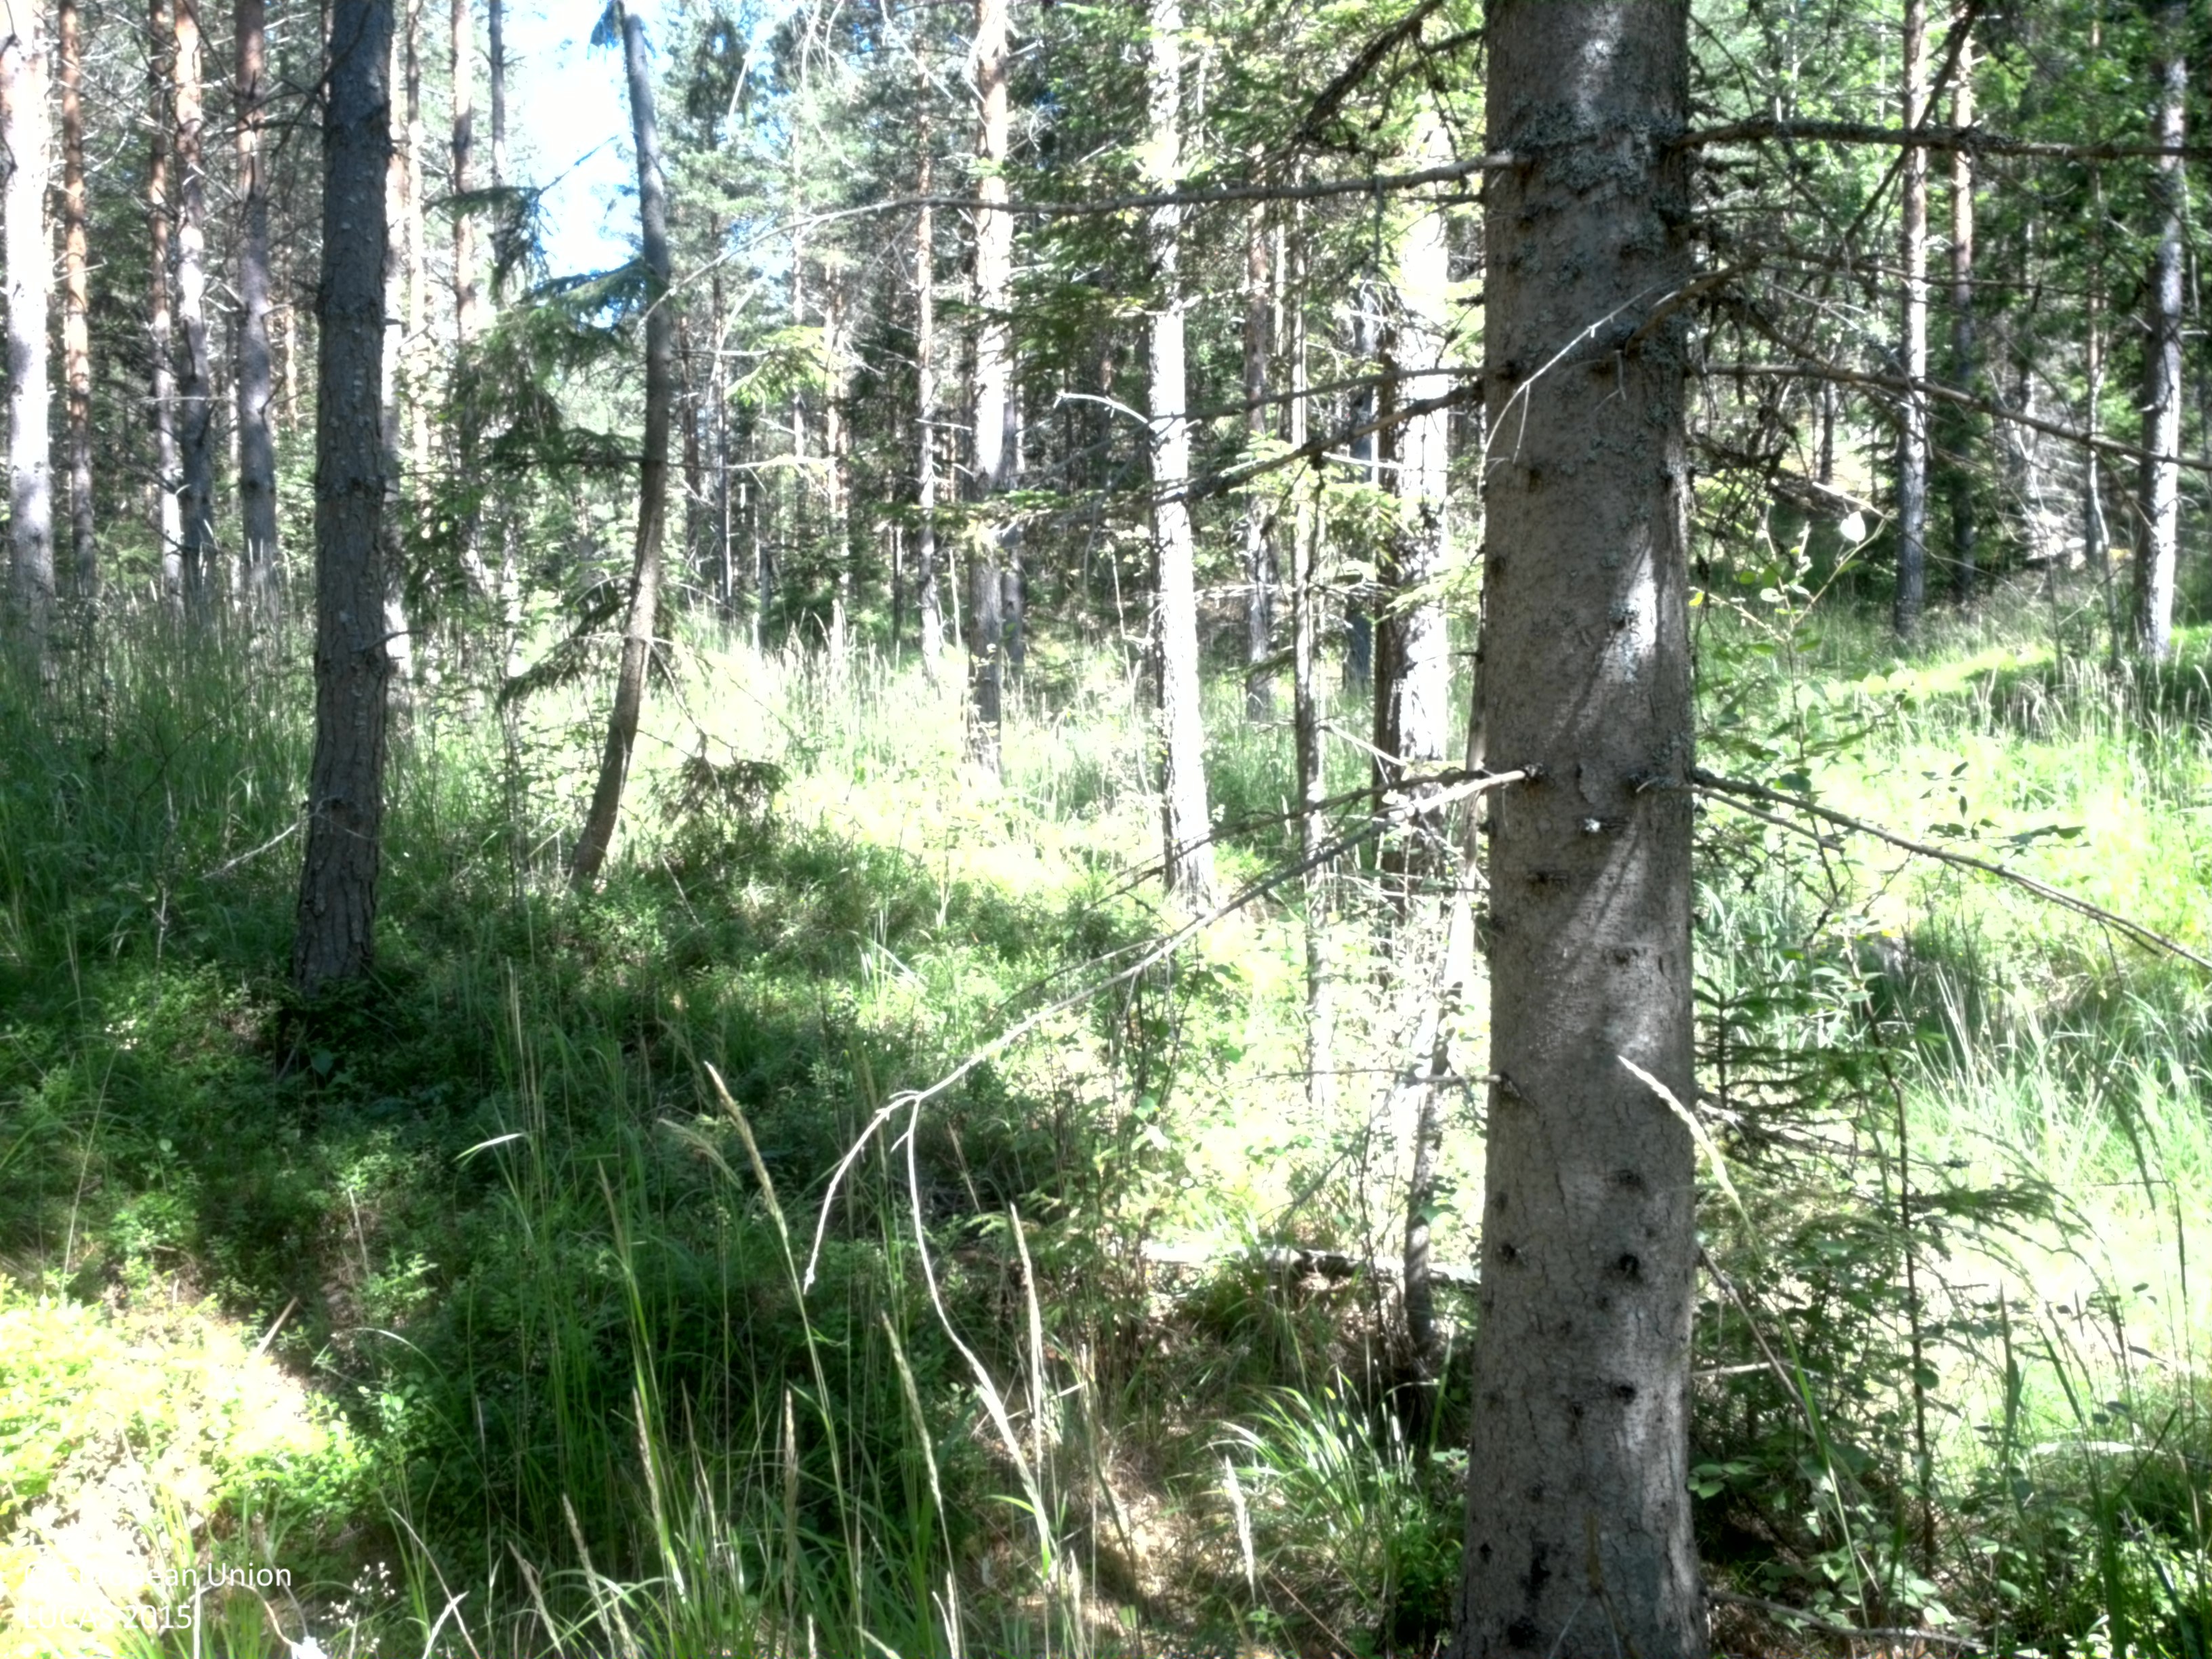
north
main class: Woodland
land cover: Pine dominated coniferous woodland
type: boreal forest
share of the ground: 50 - 75 %
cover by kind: coniferous forest trees 40 %, herbaceous plants 35 %, broadleaved forest trees 10 %, shrubs 10 %, lichens and mosses 5 %
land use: Forestry
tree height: > 5 m
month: July
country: SE
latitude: 59.6518
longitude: 14.6927
